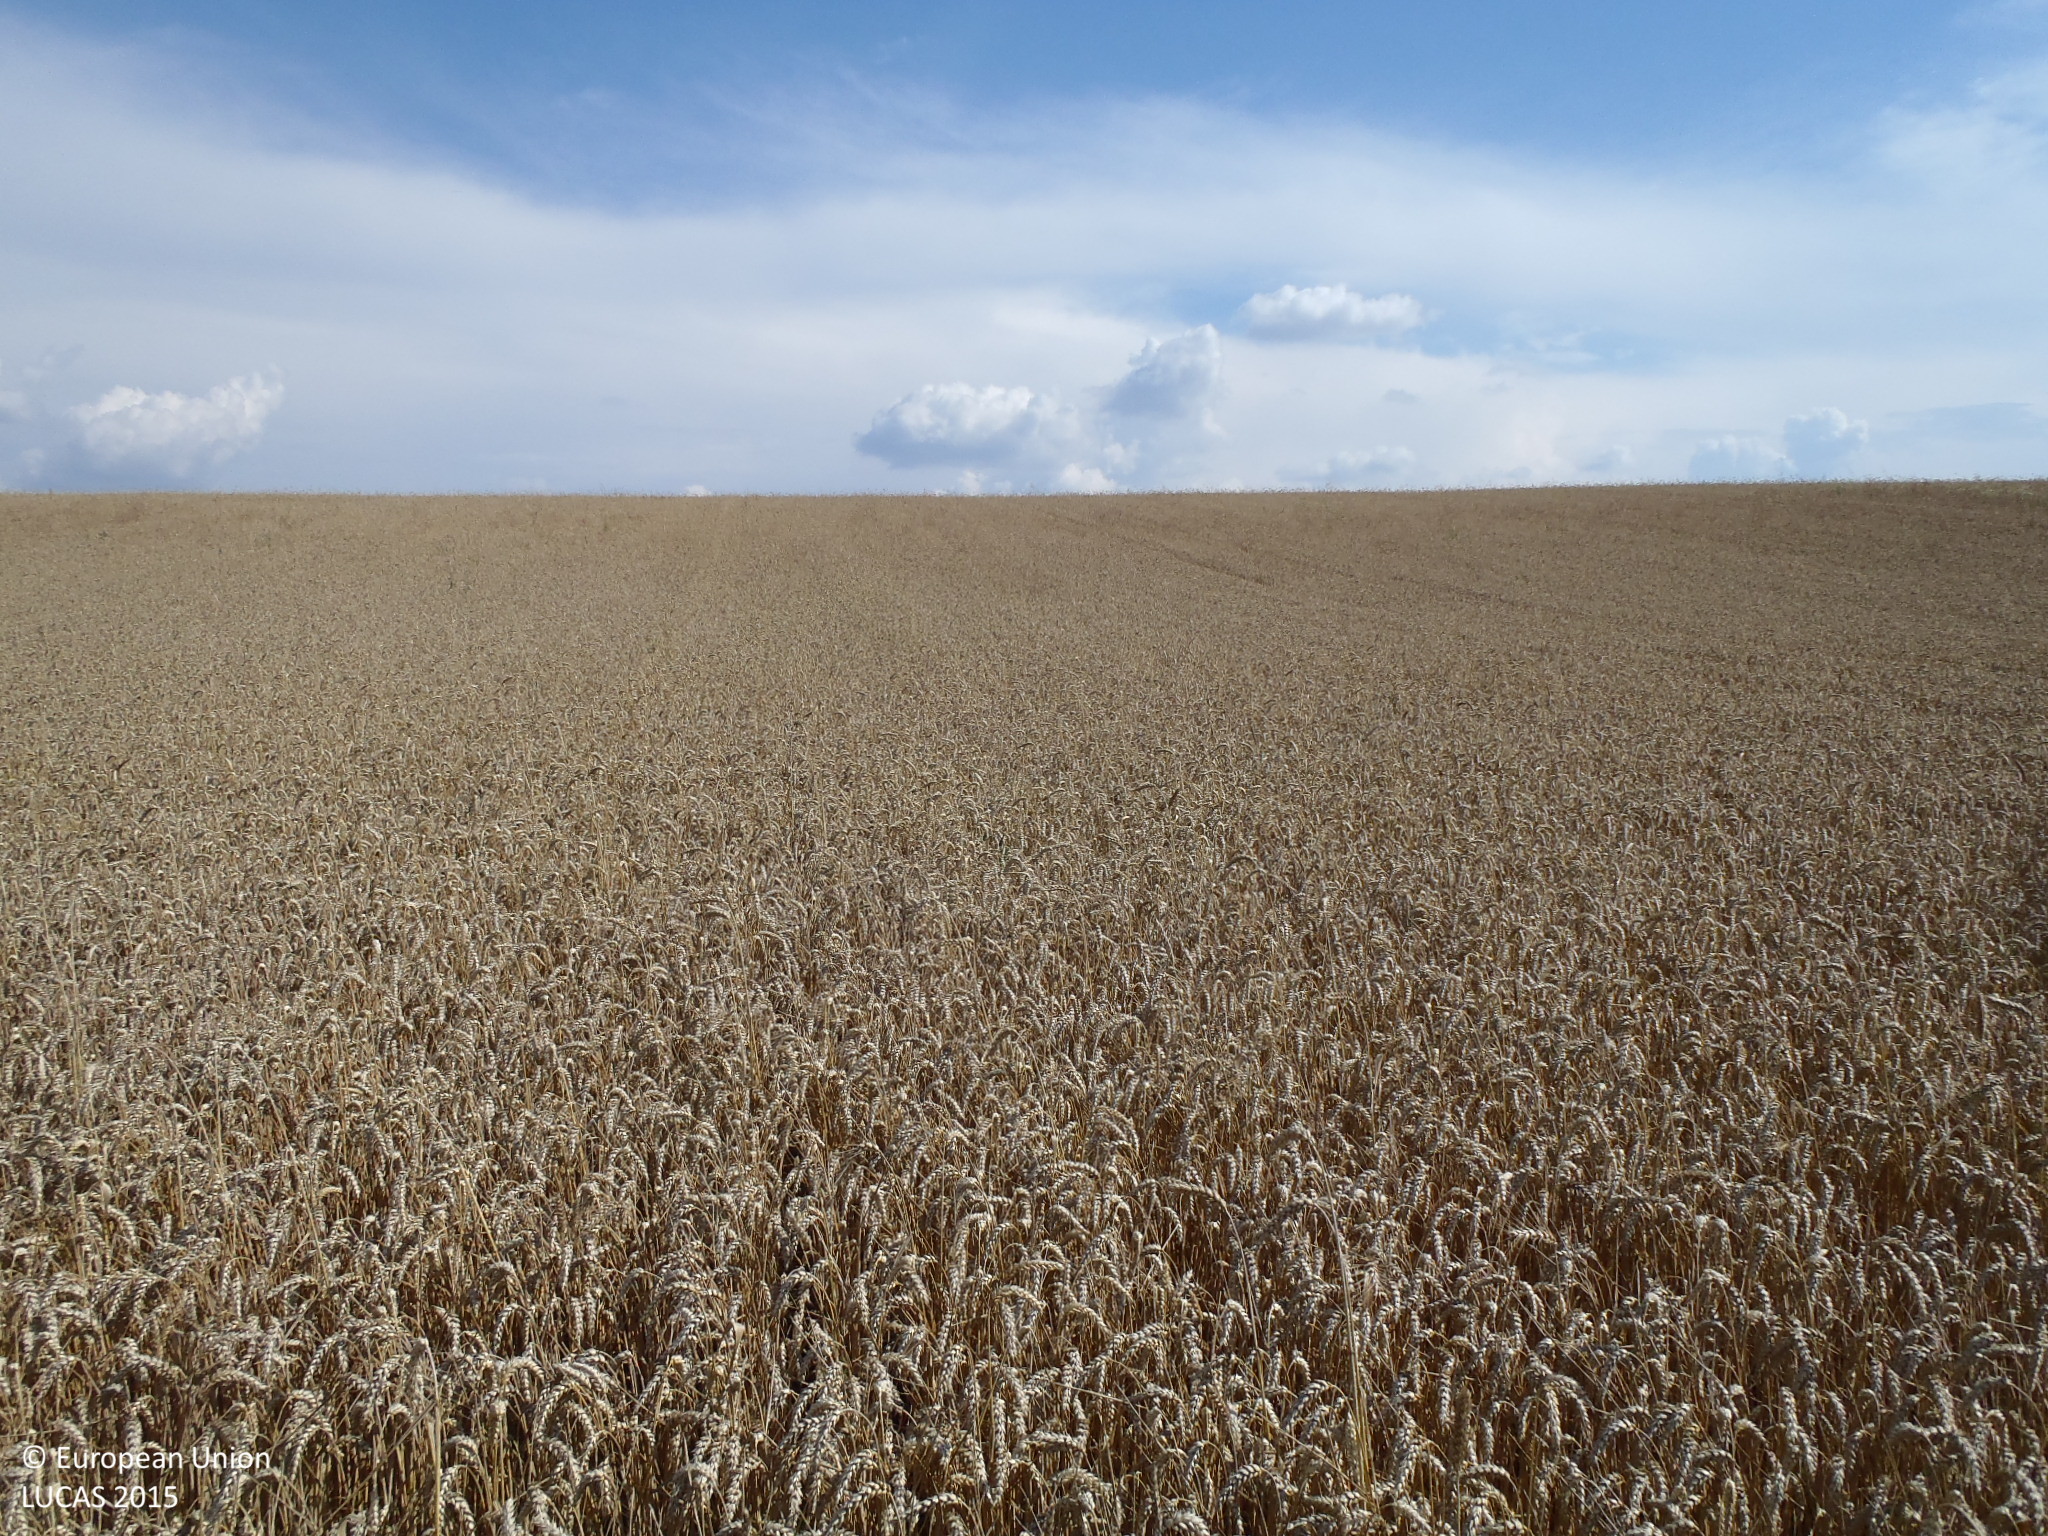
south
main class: Cropland
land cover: Common wheat
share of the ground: > 75 %
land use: Agriculture (excluding fallow land and kitchen gardens)
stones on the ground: < 10 %
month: July
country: BG
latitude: 43.9528
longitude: 26.2915
